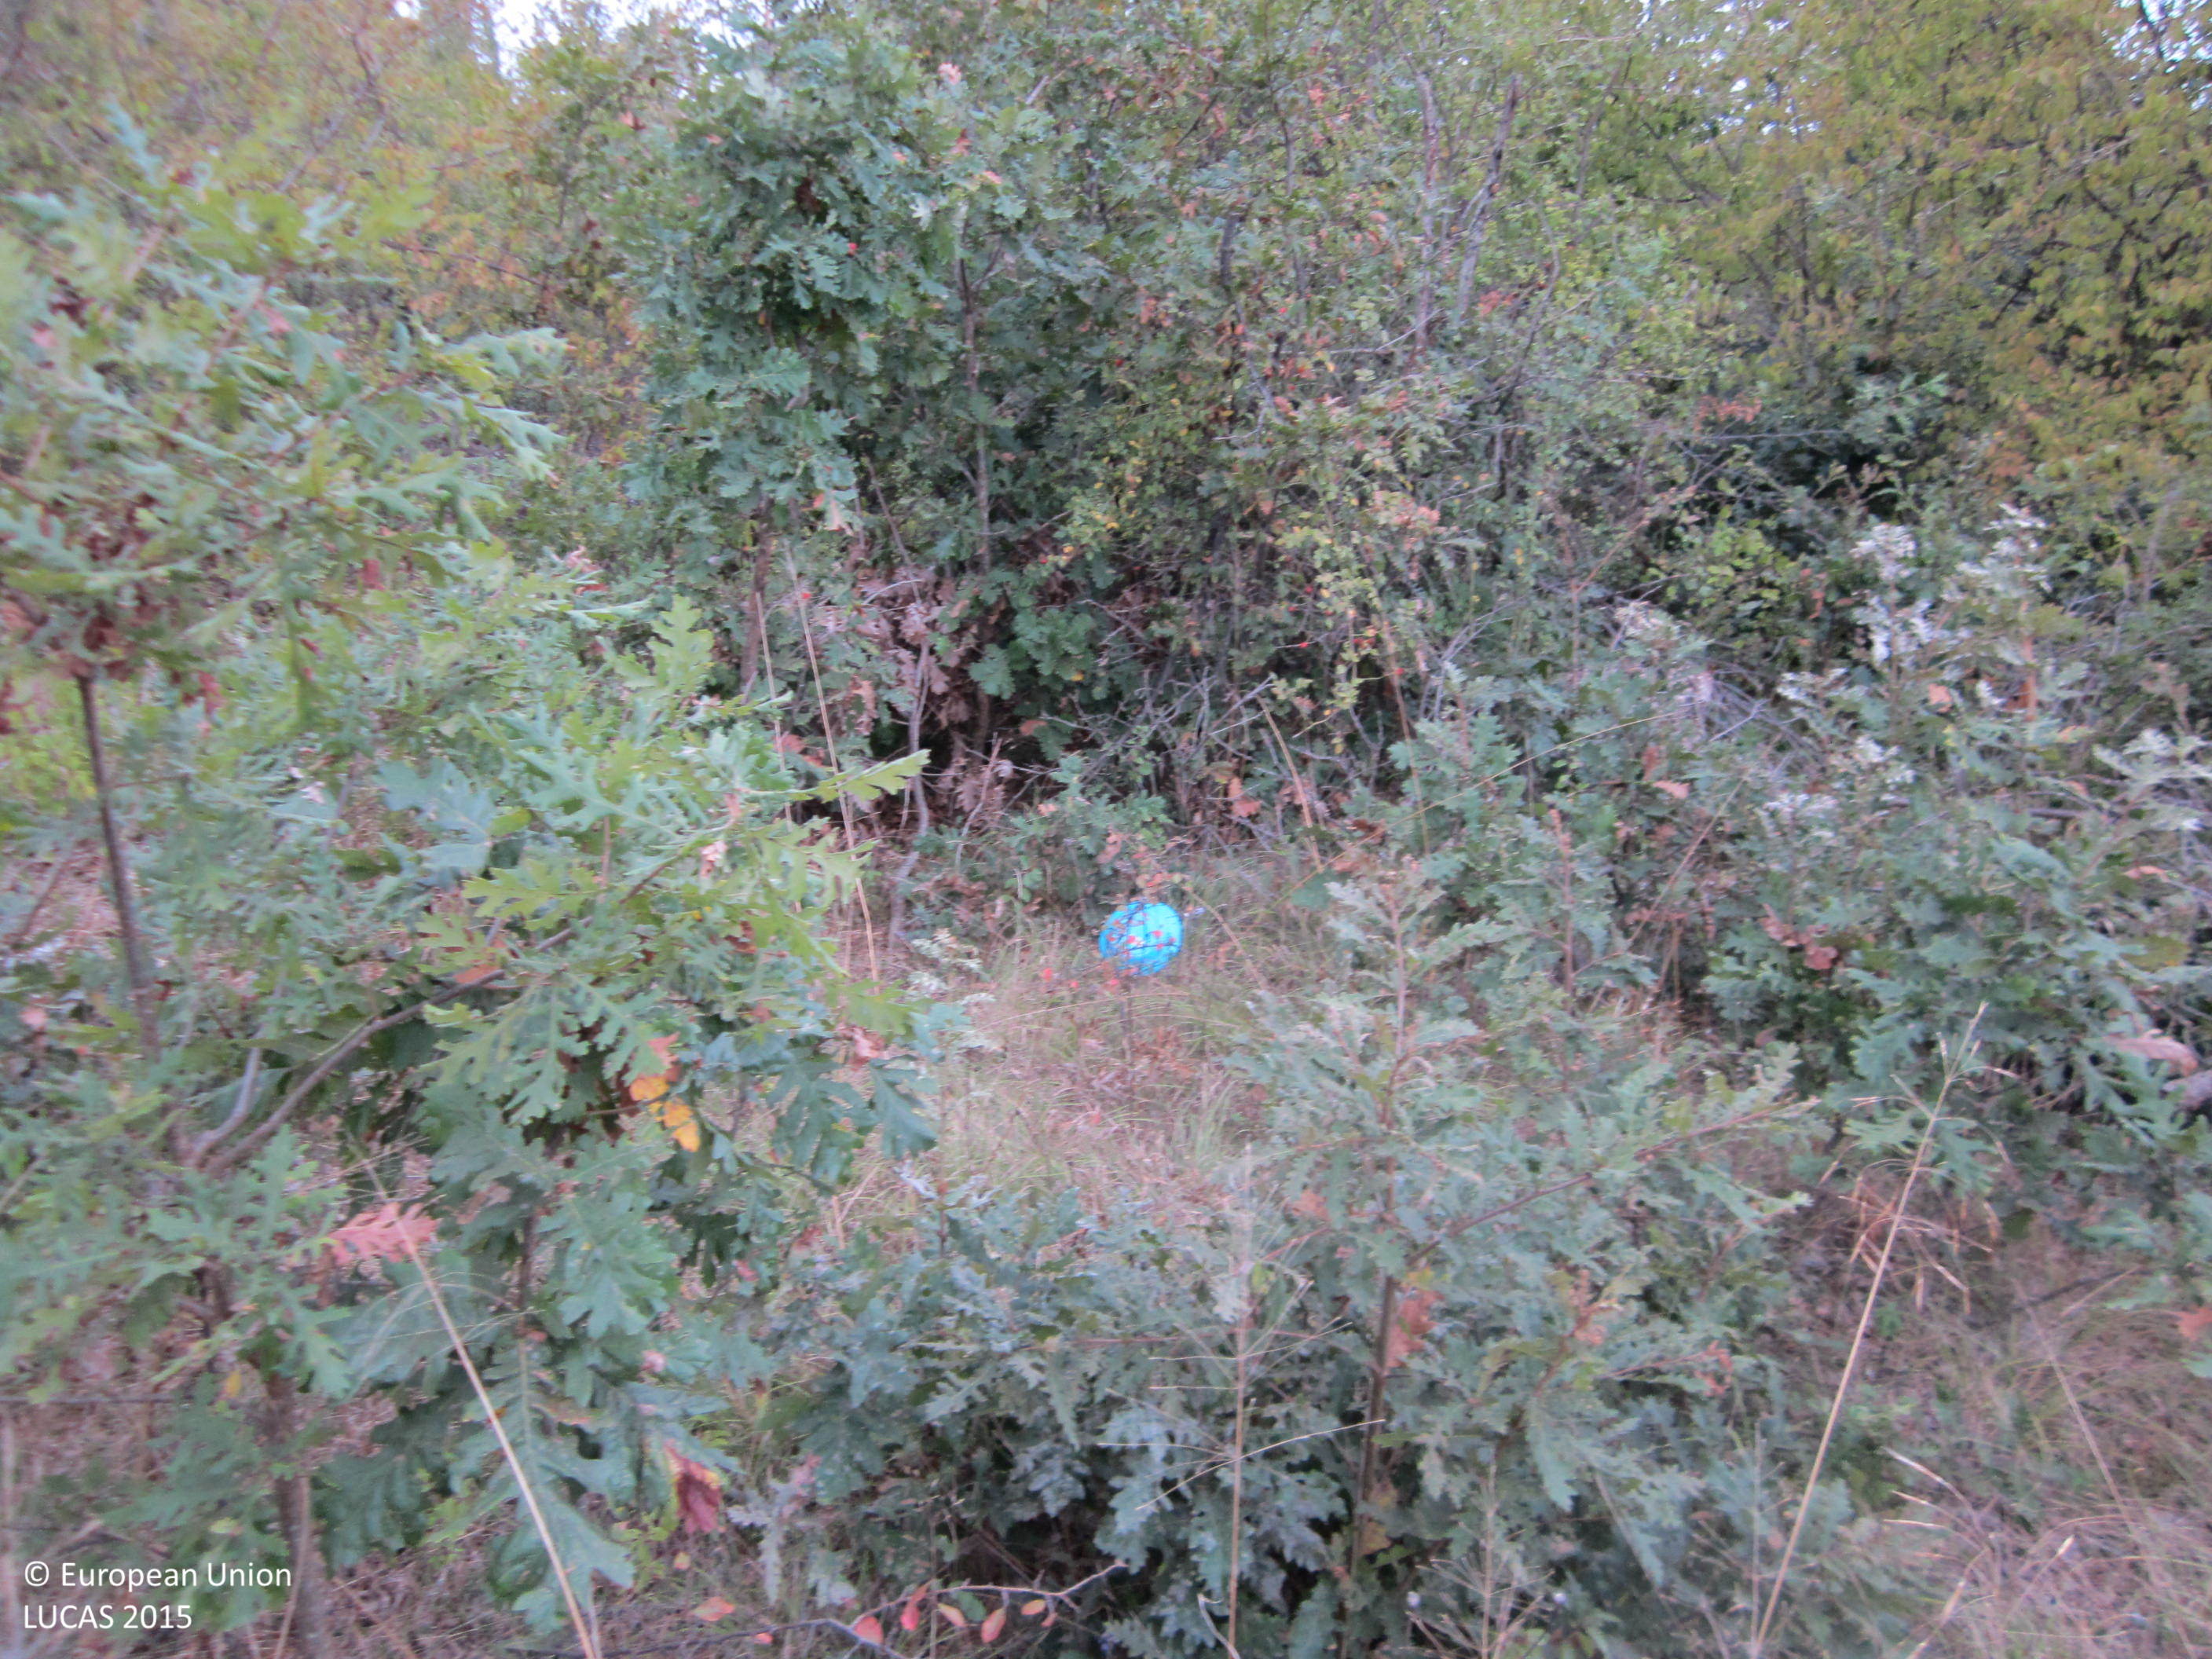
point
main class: Woodland
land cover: Broadleaved woodland
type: thermophilous deciduous forest
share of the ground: 50 - 75 %
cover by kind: broadleaved forest trees 60 %, herbaceous plants 30 %, shrubs 10 %
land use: Forestry
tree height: > 5 m
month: September
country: BG
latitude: 42.7805
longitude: 27.3651
